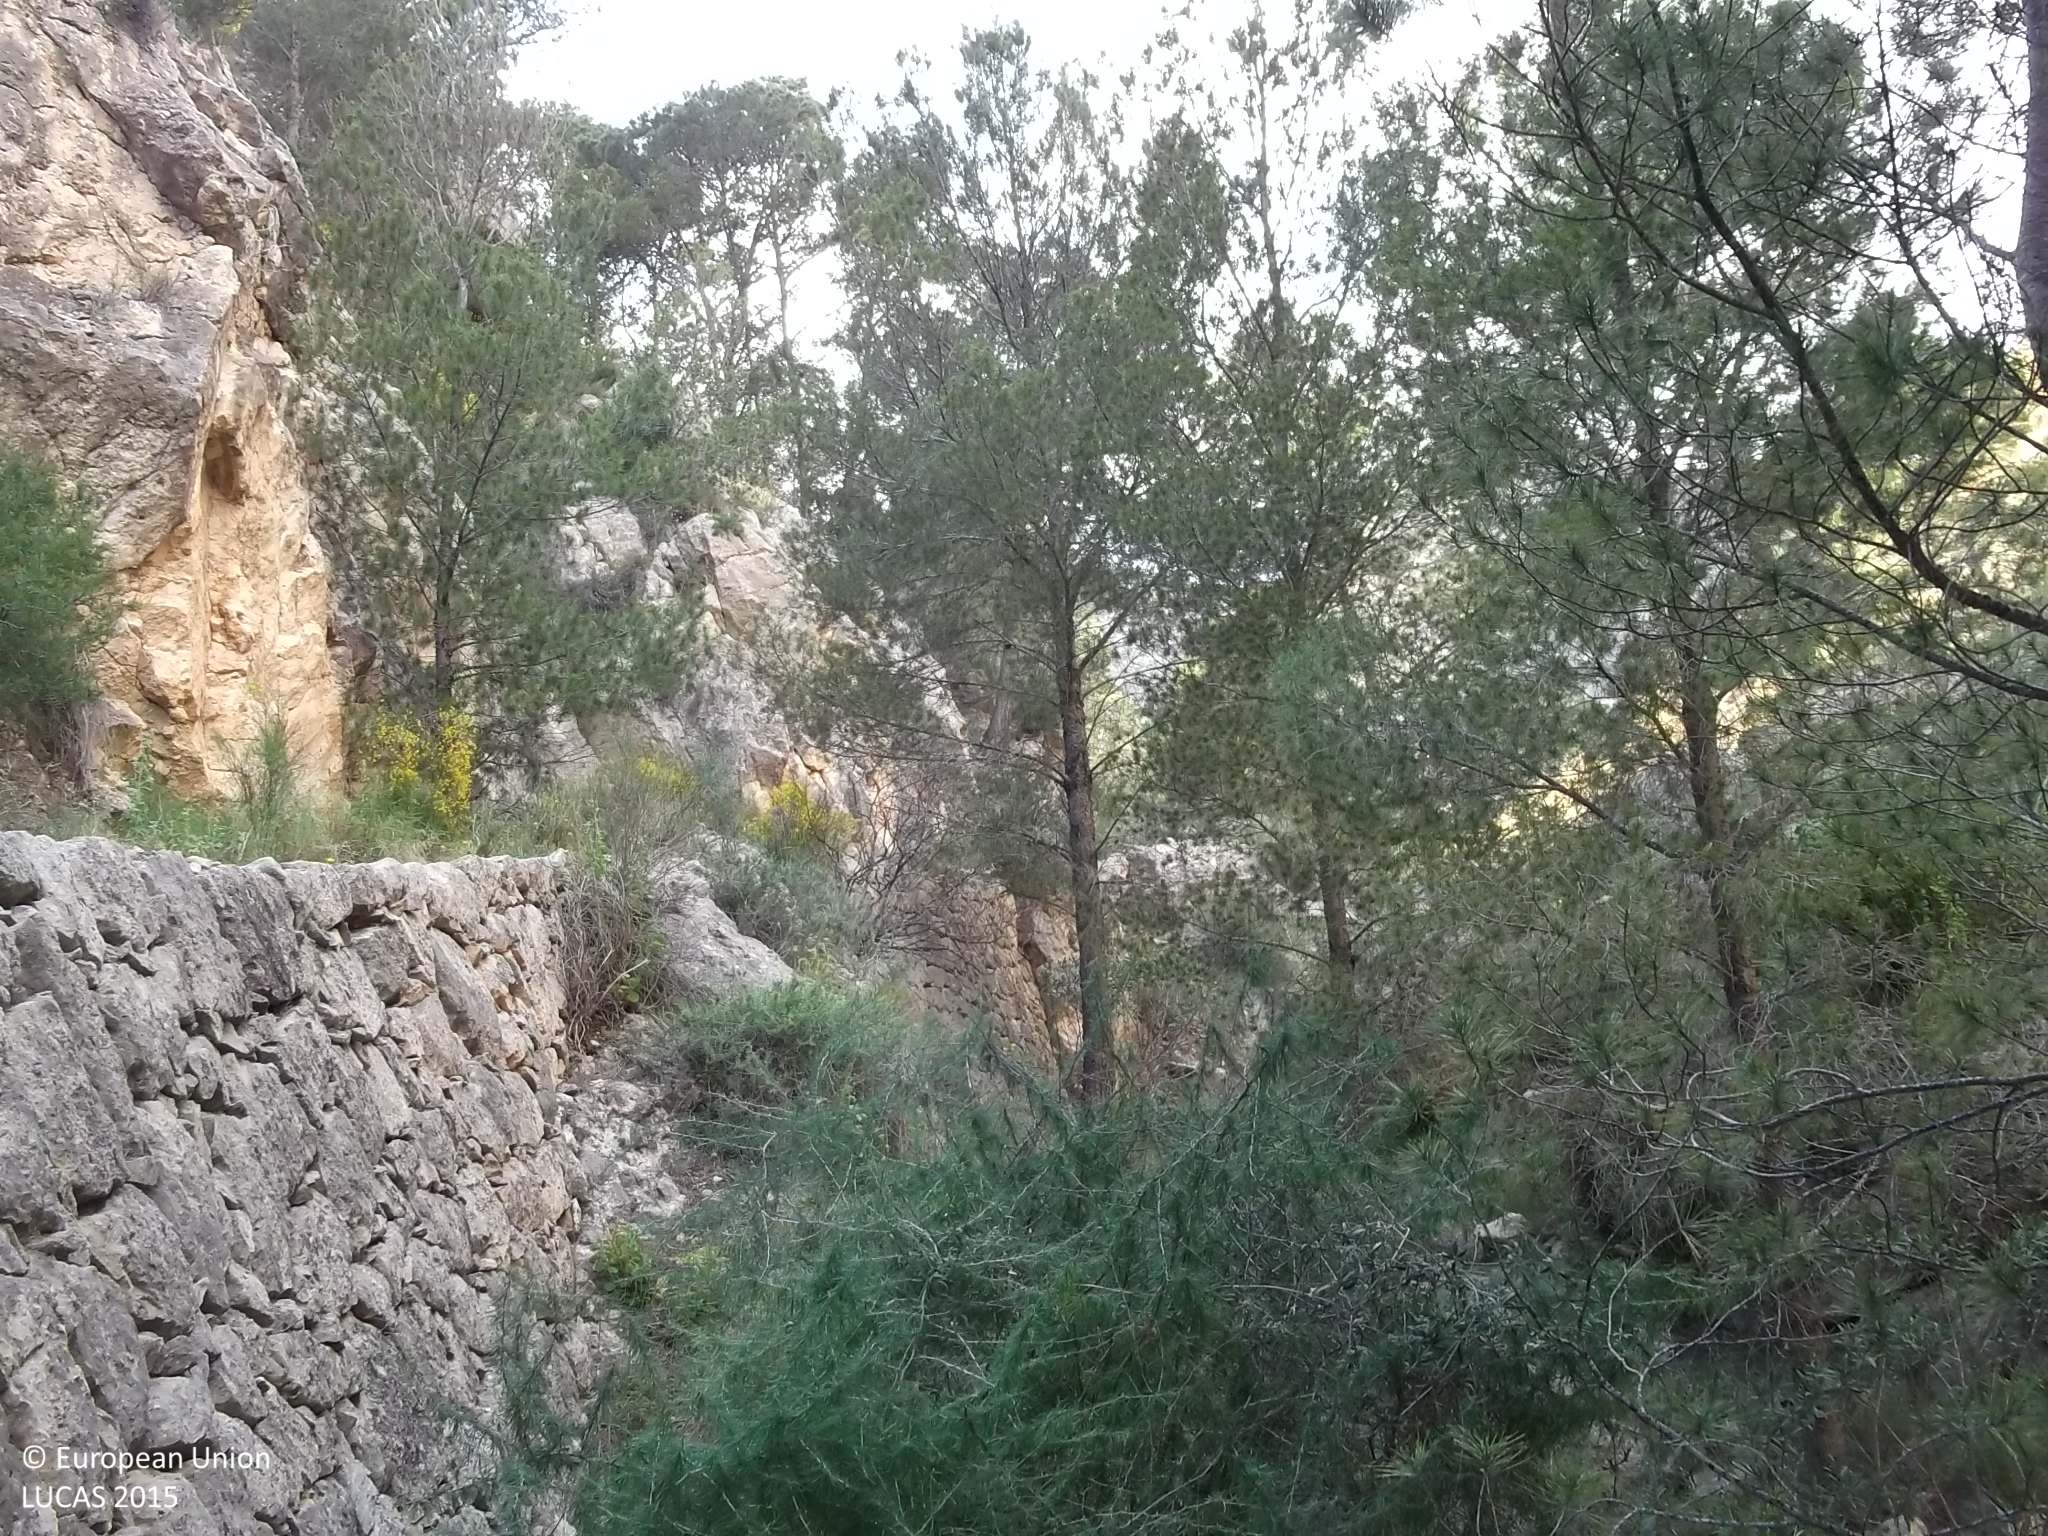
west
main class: Woodland
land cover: Pine dominated coniferous woodland
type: coniferous forest of the mediterranean region
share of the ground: 25 - 50 %
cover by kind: herbaceous plants 50 %, coniferous forest trees 25 %, shrubs 25 %
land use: Semi-natural and natural areas not in use
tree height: > 5 m
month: April
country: ES
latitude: 38.1487
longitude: -1.3179
